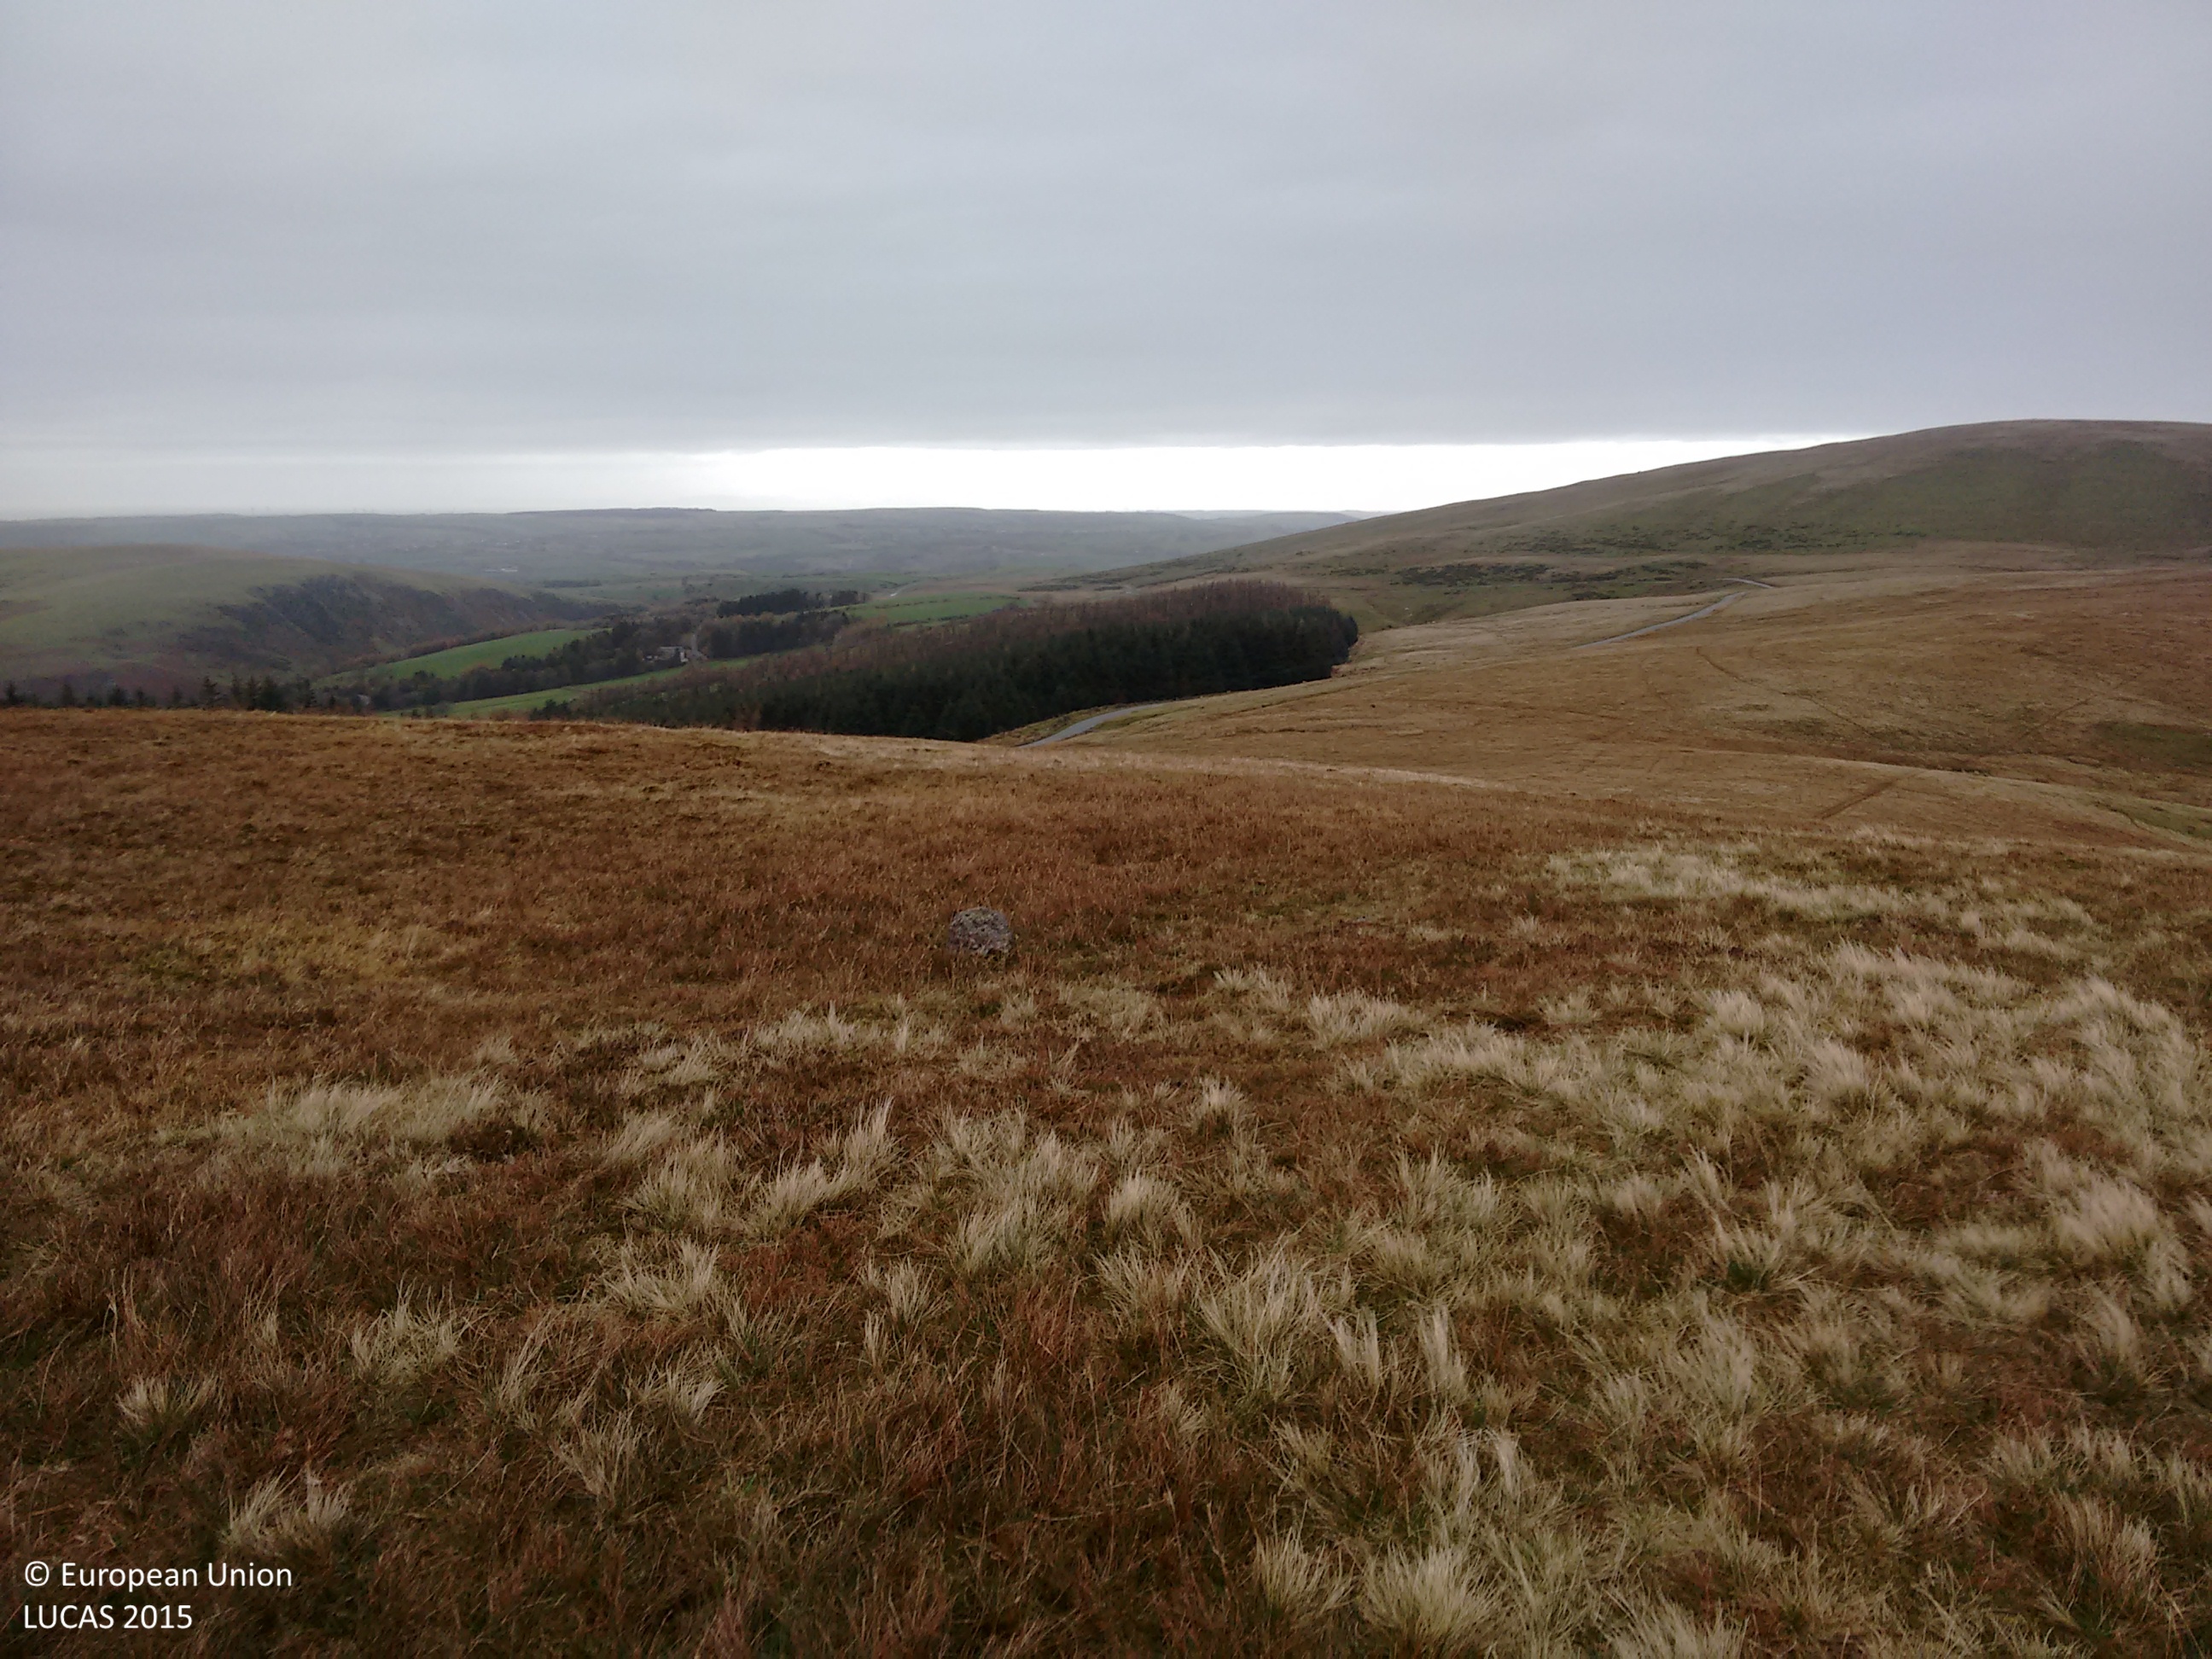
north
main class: Grassland
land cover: Grassland without tree/shrub cover
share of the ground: > 75 %
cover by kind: herbaceous plants 100 %
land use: Agriculture (excluding fallow land and kitchen gardens)
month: November
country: GB
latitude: 54.4914
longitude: -3.4346
